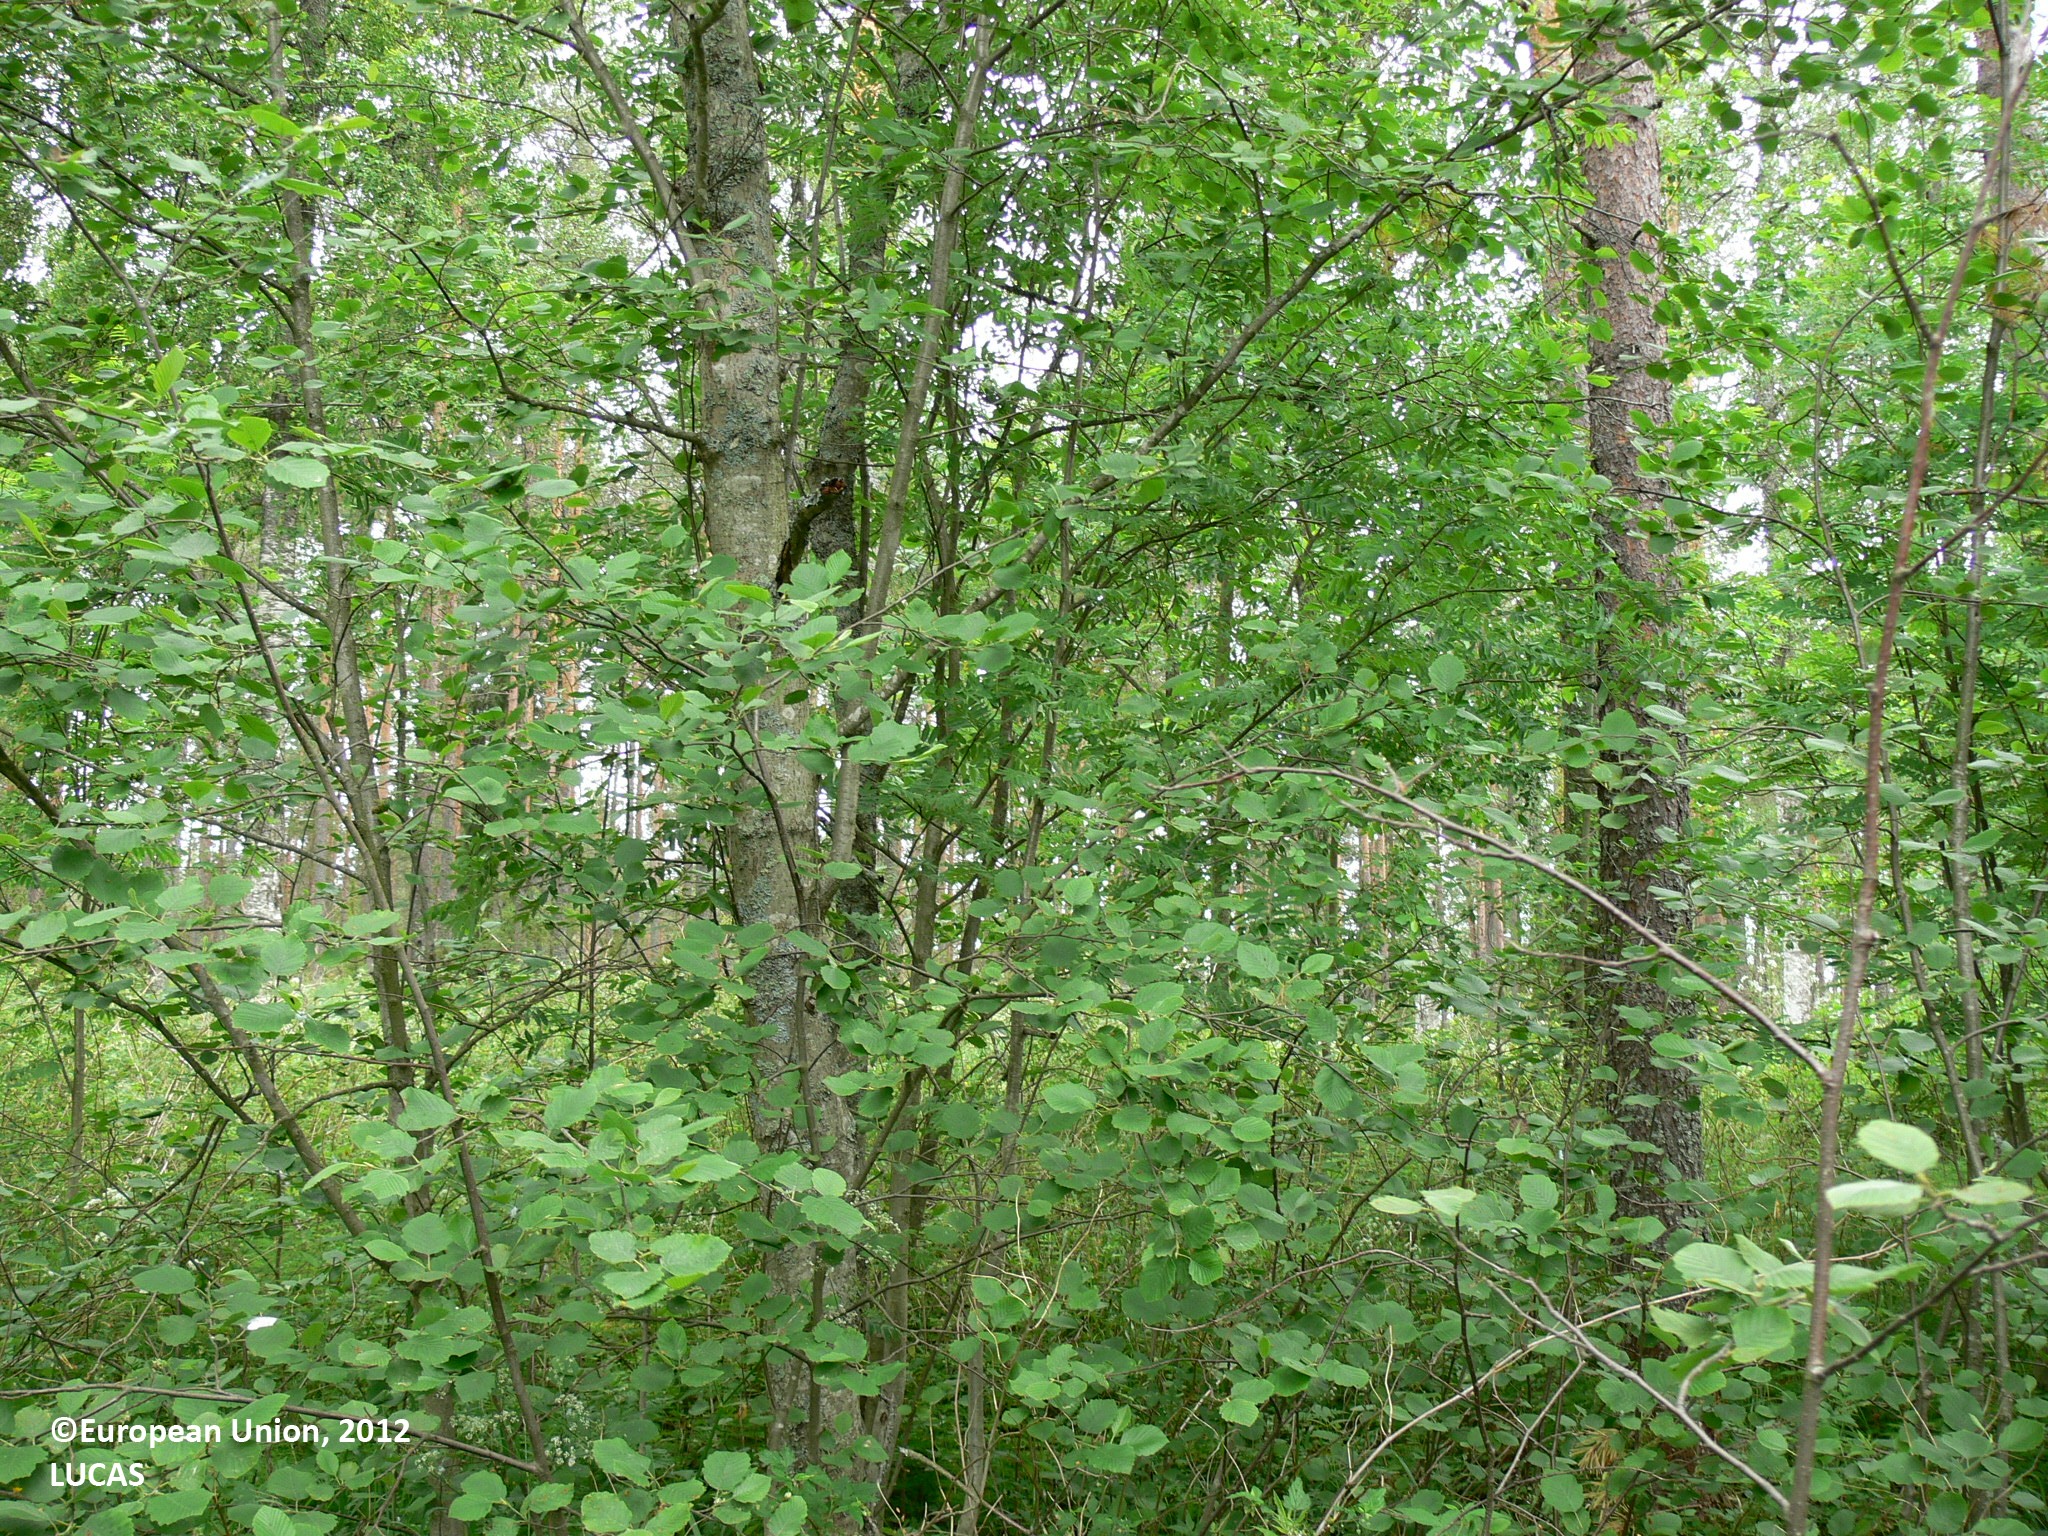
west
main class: Woodland
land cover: Pine dominated mixed woodland
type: boreal forest
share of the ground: > 75 %
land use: Forestry
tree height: > 5 m
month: June
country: FI
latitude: 62.7773
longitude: 29.3344
